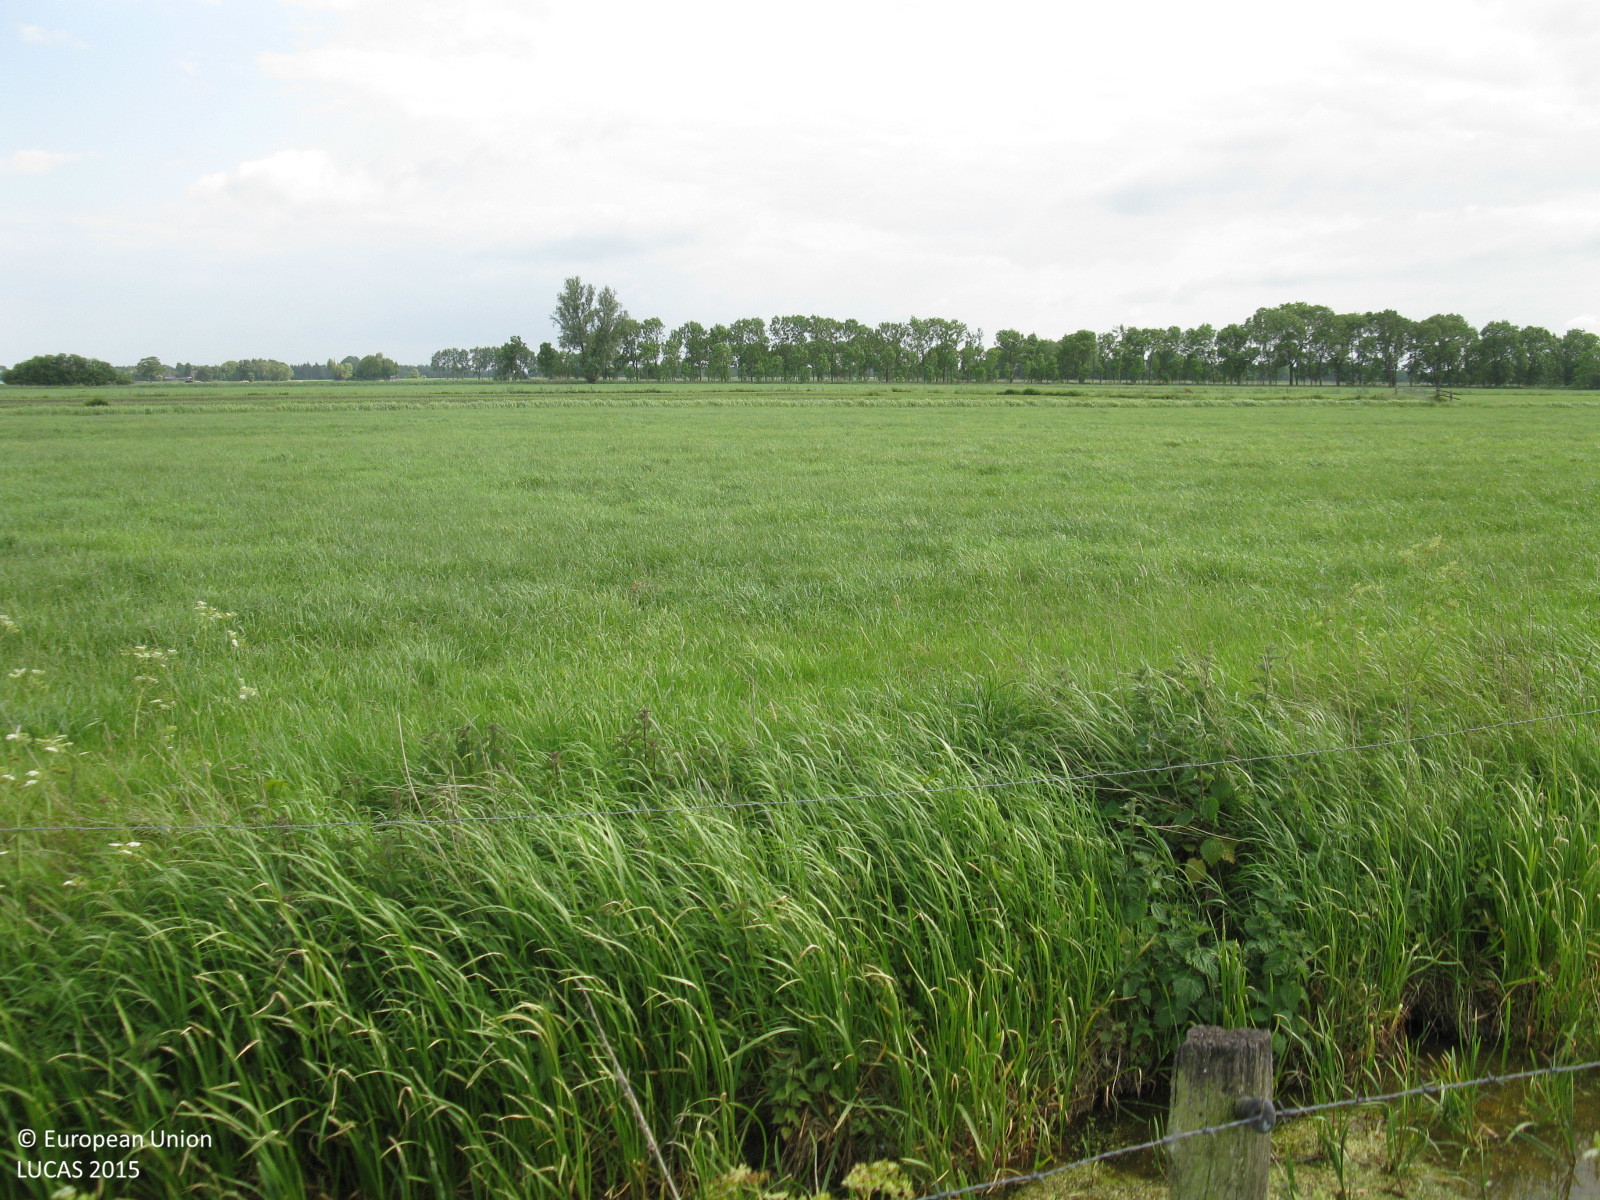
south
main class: Grassland
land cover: Grassland without tree/shrub cover
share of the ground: > 75 %
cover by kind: herbaceous plants 100 %
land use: Agriculture (excluding fallow land and kitchen gardens)
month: June
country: DE
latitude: 53.3365
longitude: 8.3337
